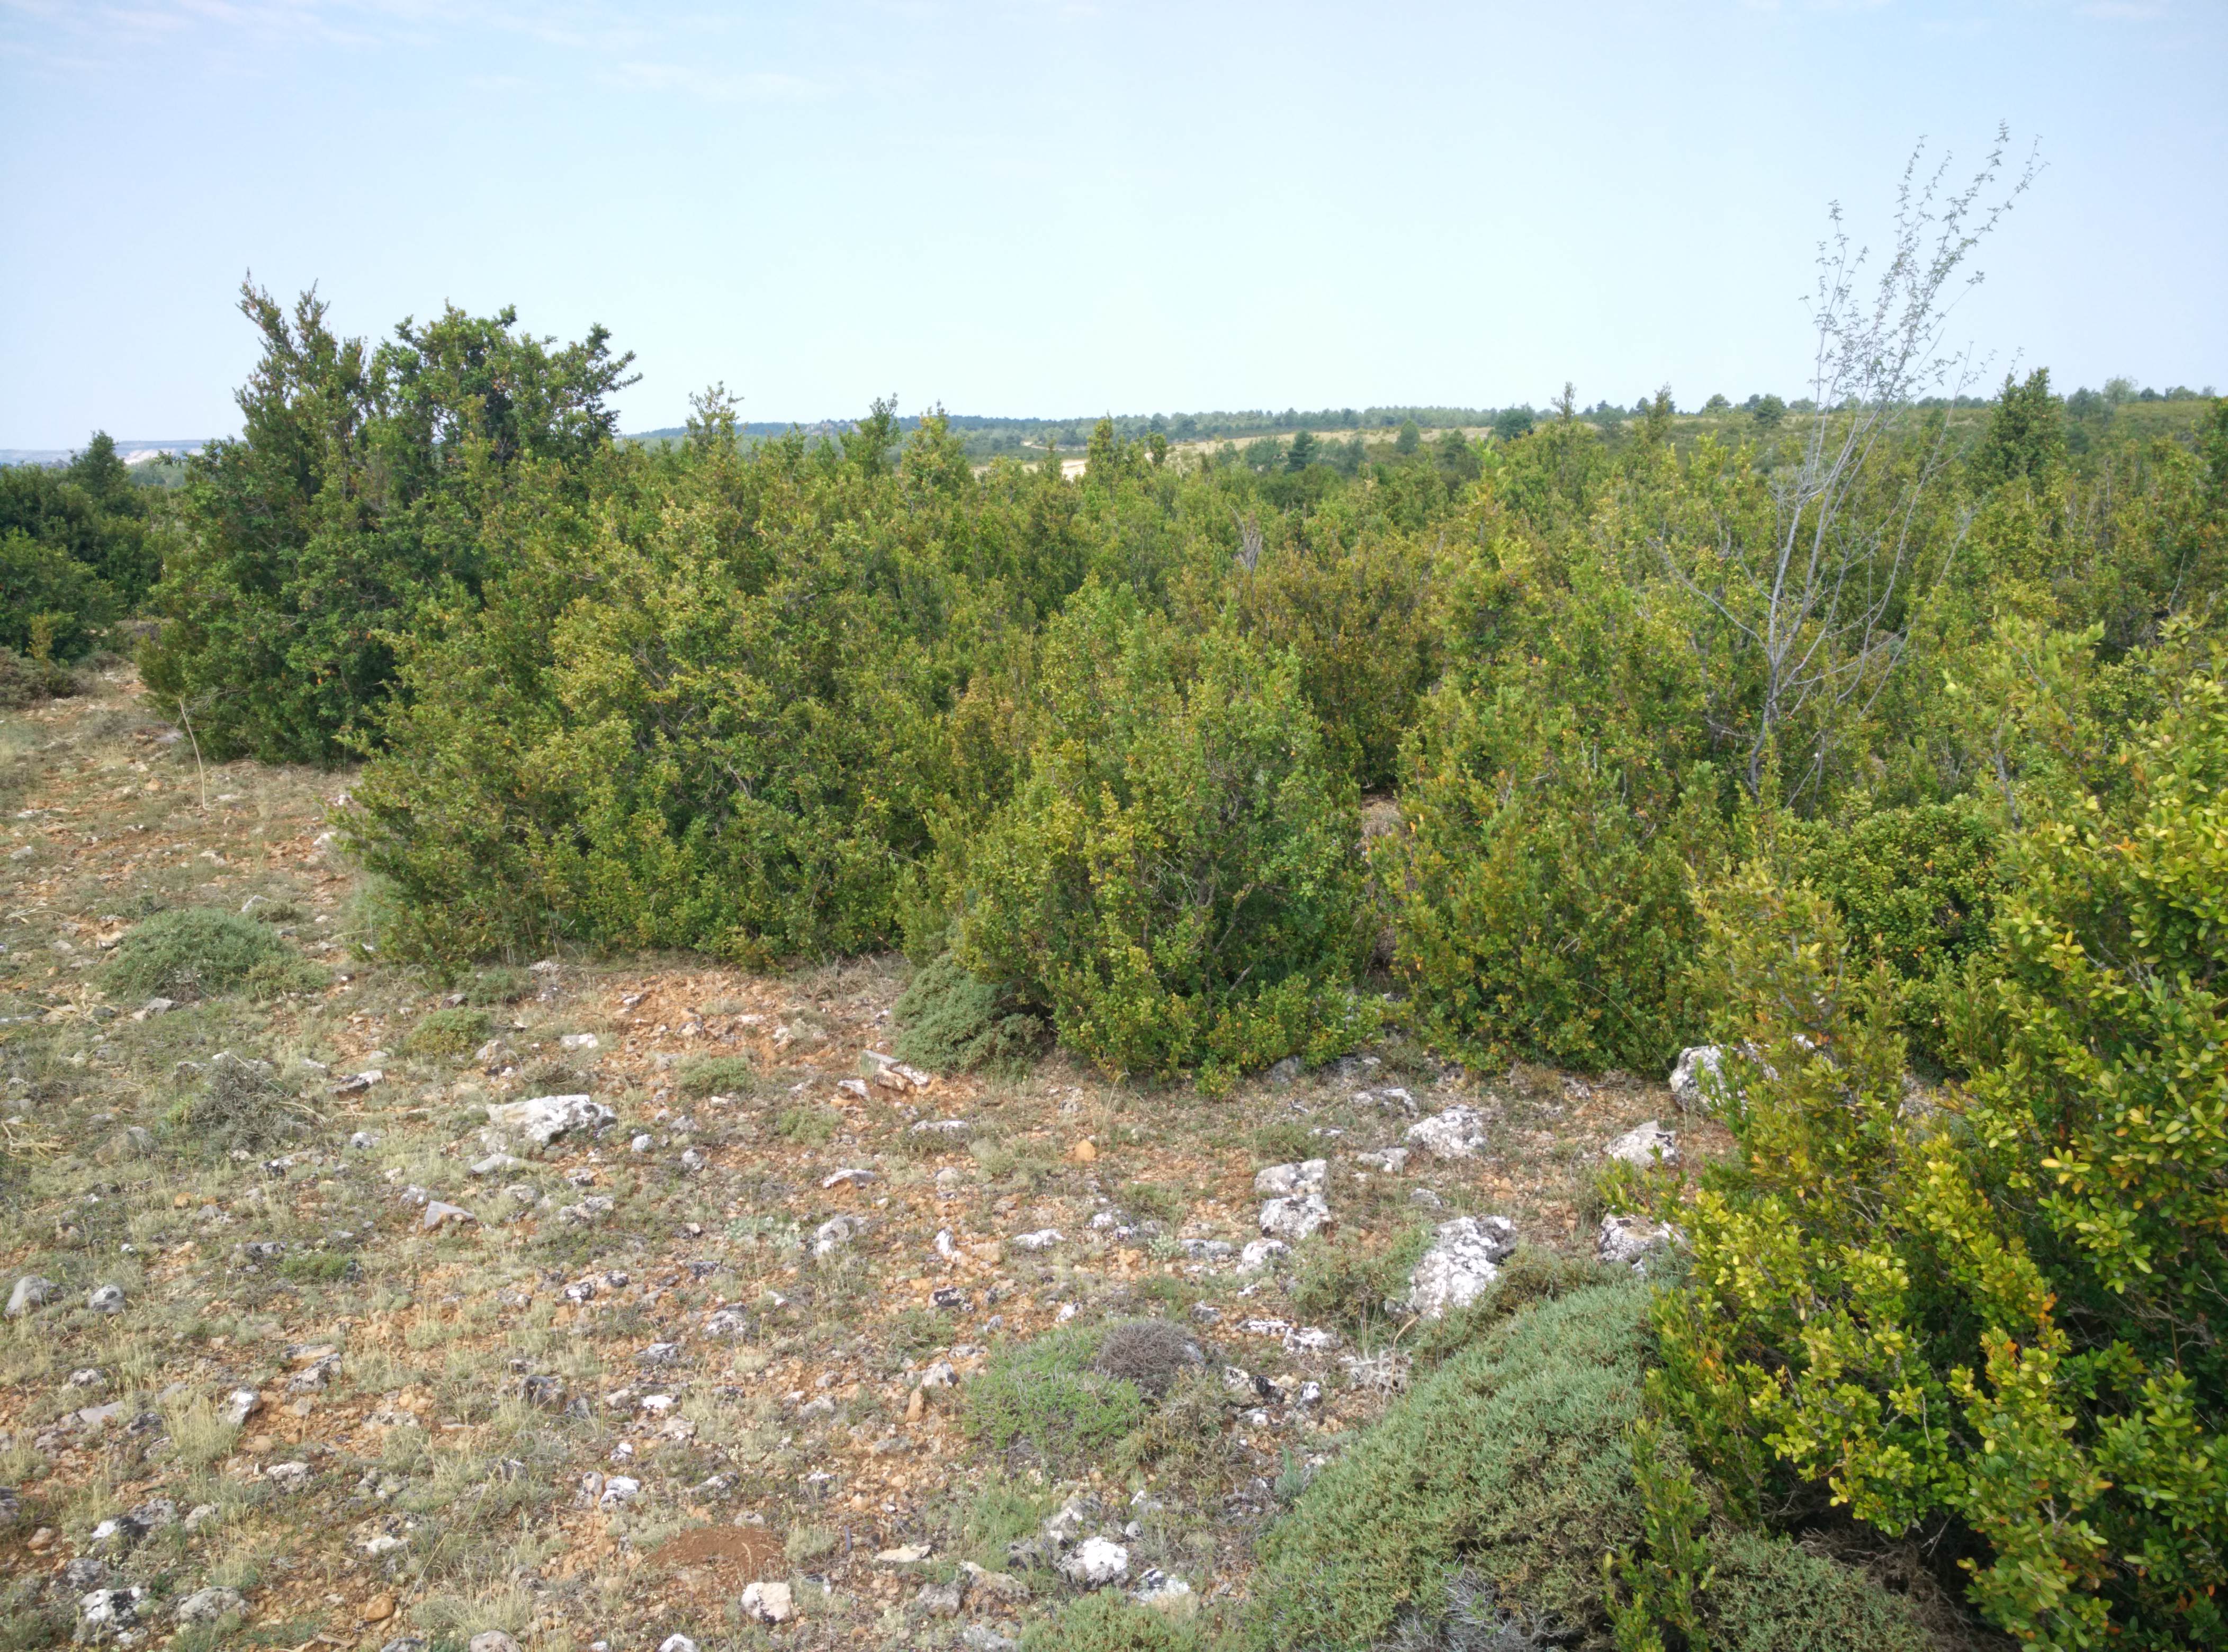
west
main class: Shrubland
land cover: Shrubland without tree cover
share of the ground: 50 - 75 %
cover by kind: shrubs 60 %, unconsolidated bare surface 35 %, herbaceous plants 5 %
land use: Semi-natural and natural areas not in use
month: June
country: ES
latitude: 40.6986
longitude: -1.9865
